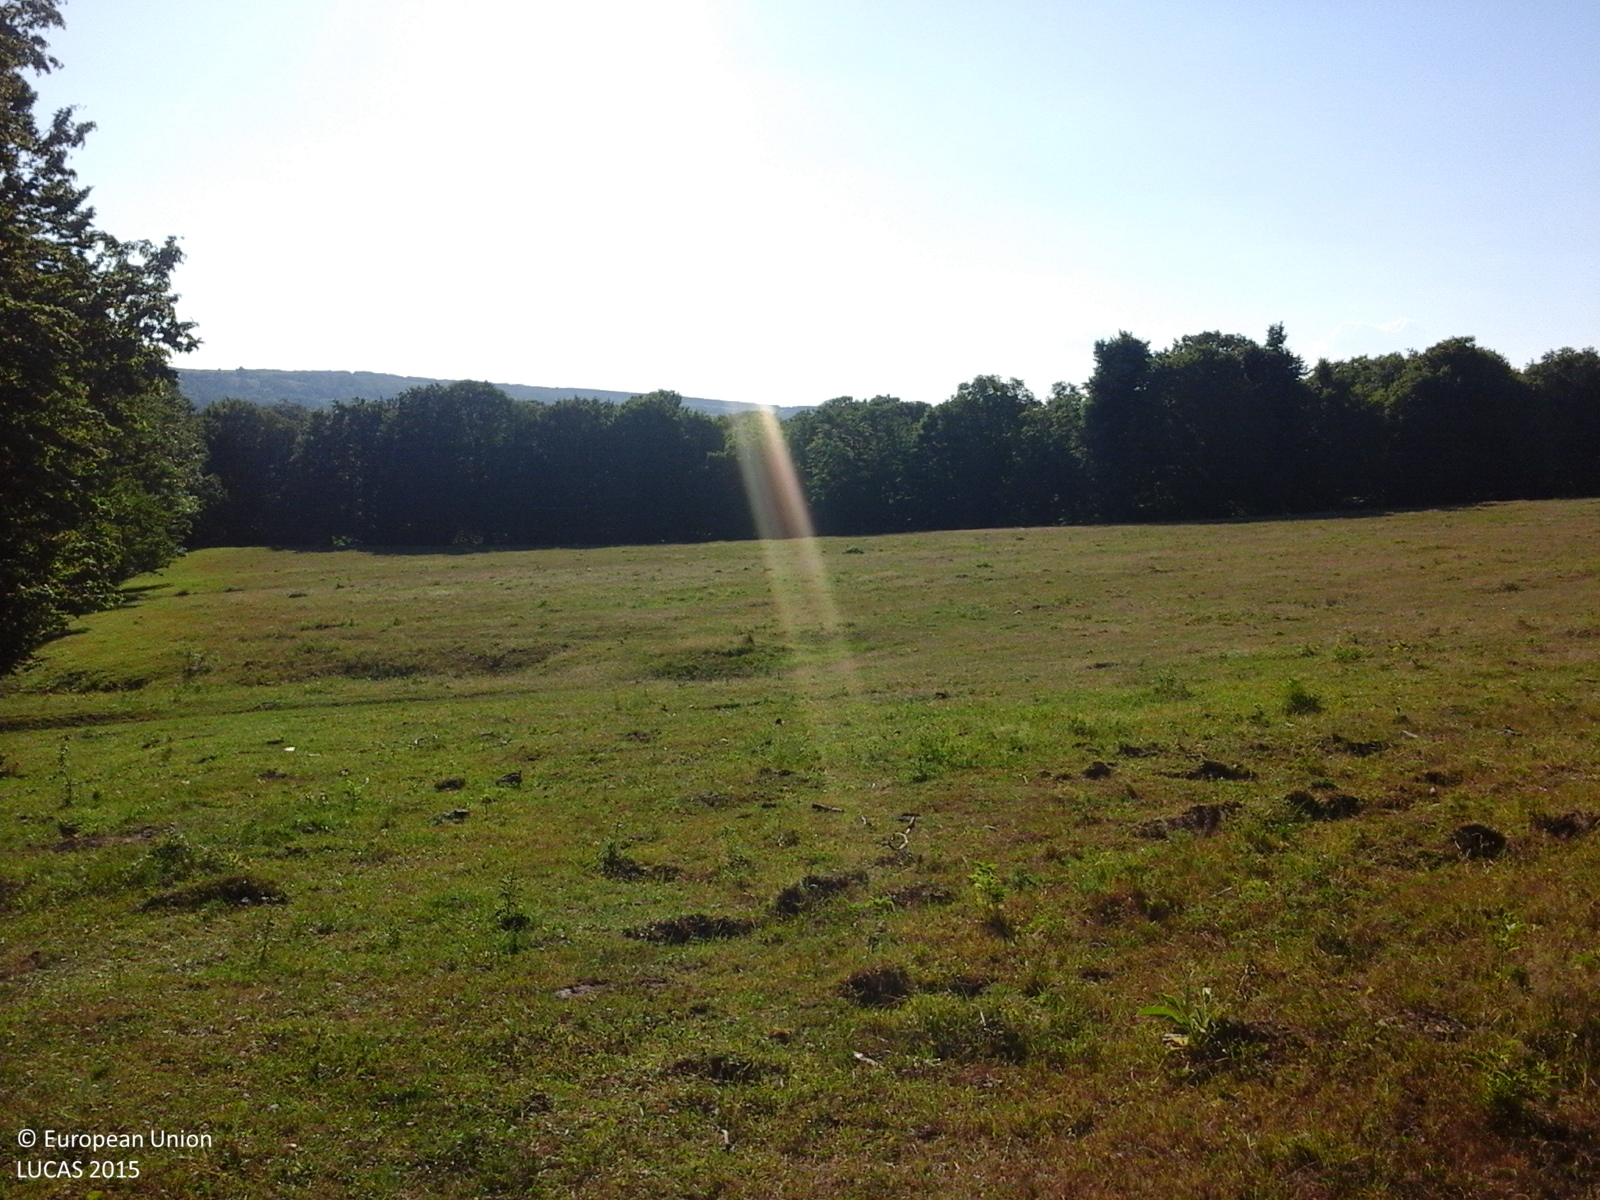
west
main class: Grassland
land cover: Grassland without tree/shrub cover
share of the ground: > 75 %
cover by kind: herbaceous plants 100 %
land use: Agriculture (excluding fallow land and kitchen gardens)
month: June
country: RO
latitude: 46.9828
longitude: 27.5623
